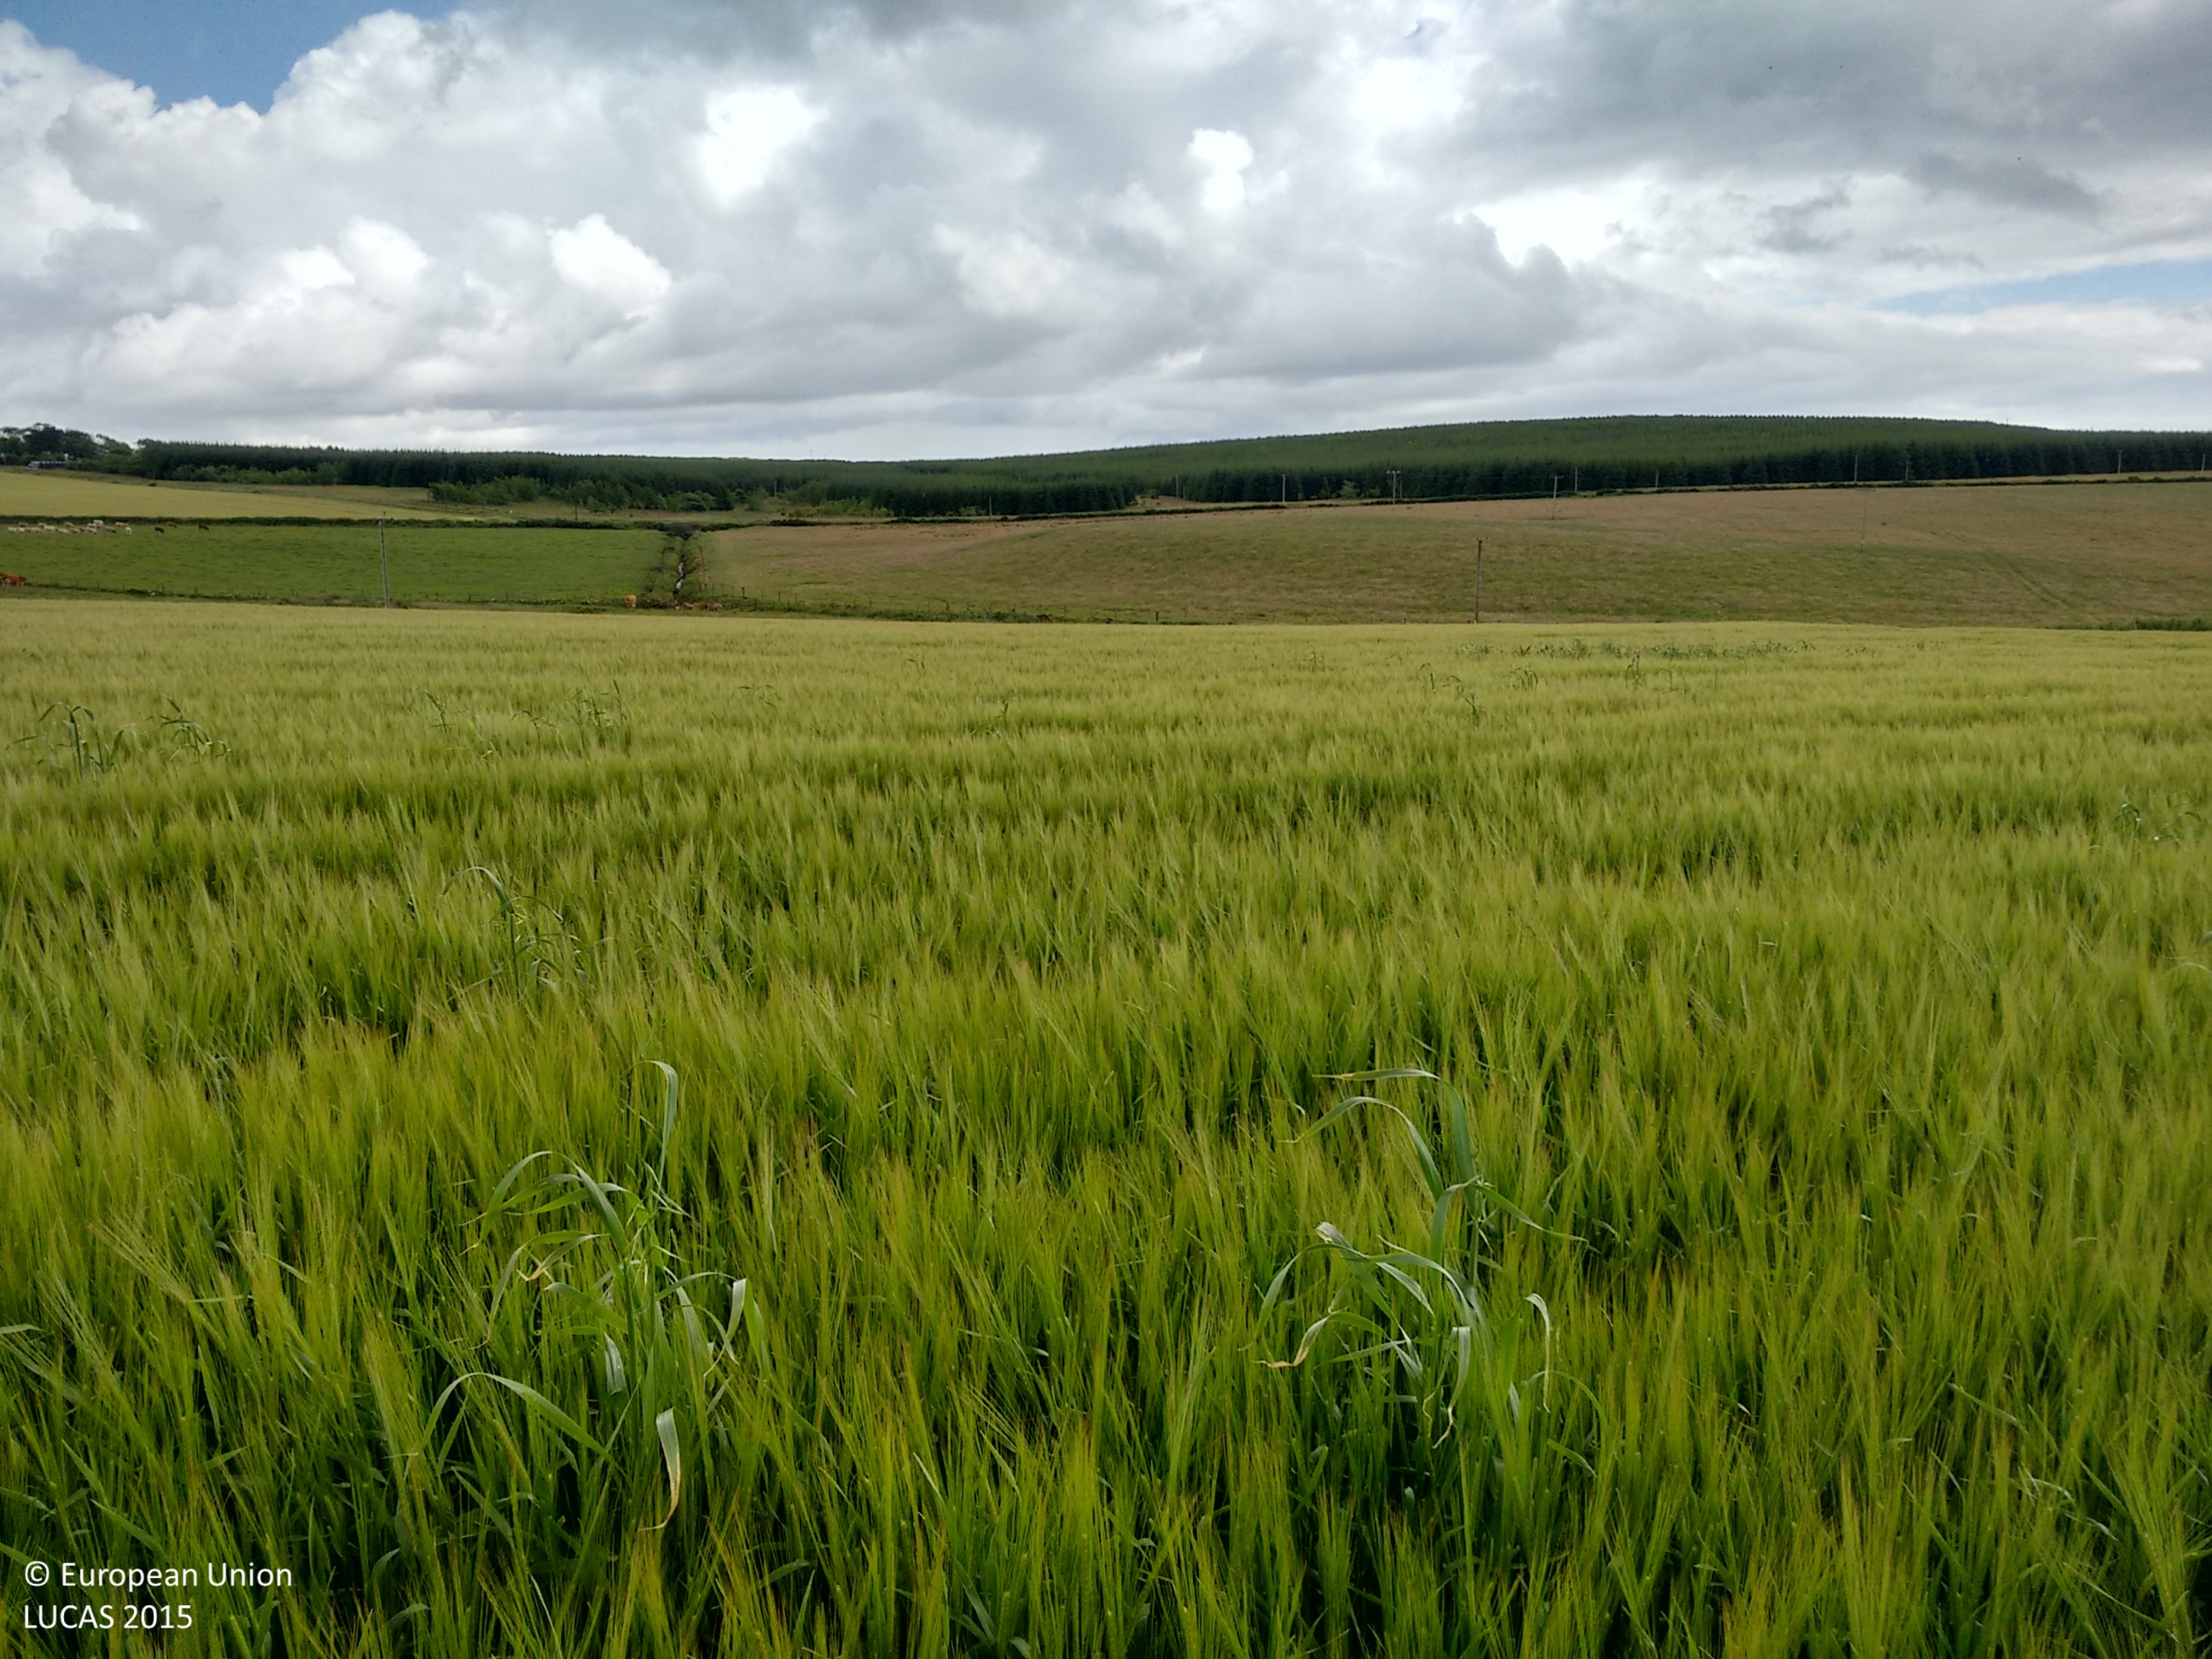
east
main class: Cropland
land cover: Barley
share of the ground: > 75 %
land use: Agriculture (excluding fallow land and kitchen gardens)
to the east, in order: Barley; Electric lines; Fences; Ditches and canals; Fences; Grassland without tree/shrub cover
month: July
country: GB
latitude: 57.4198
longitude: -2.0513
